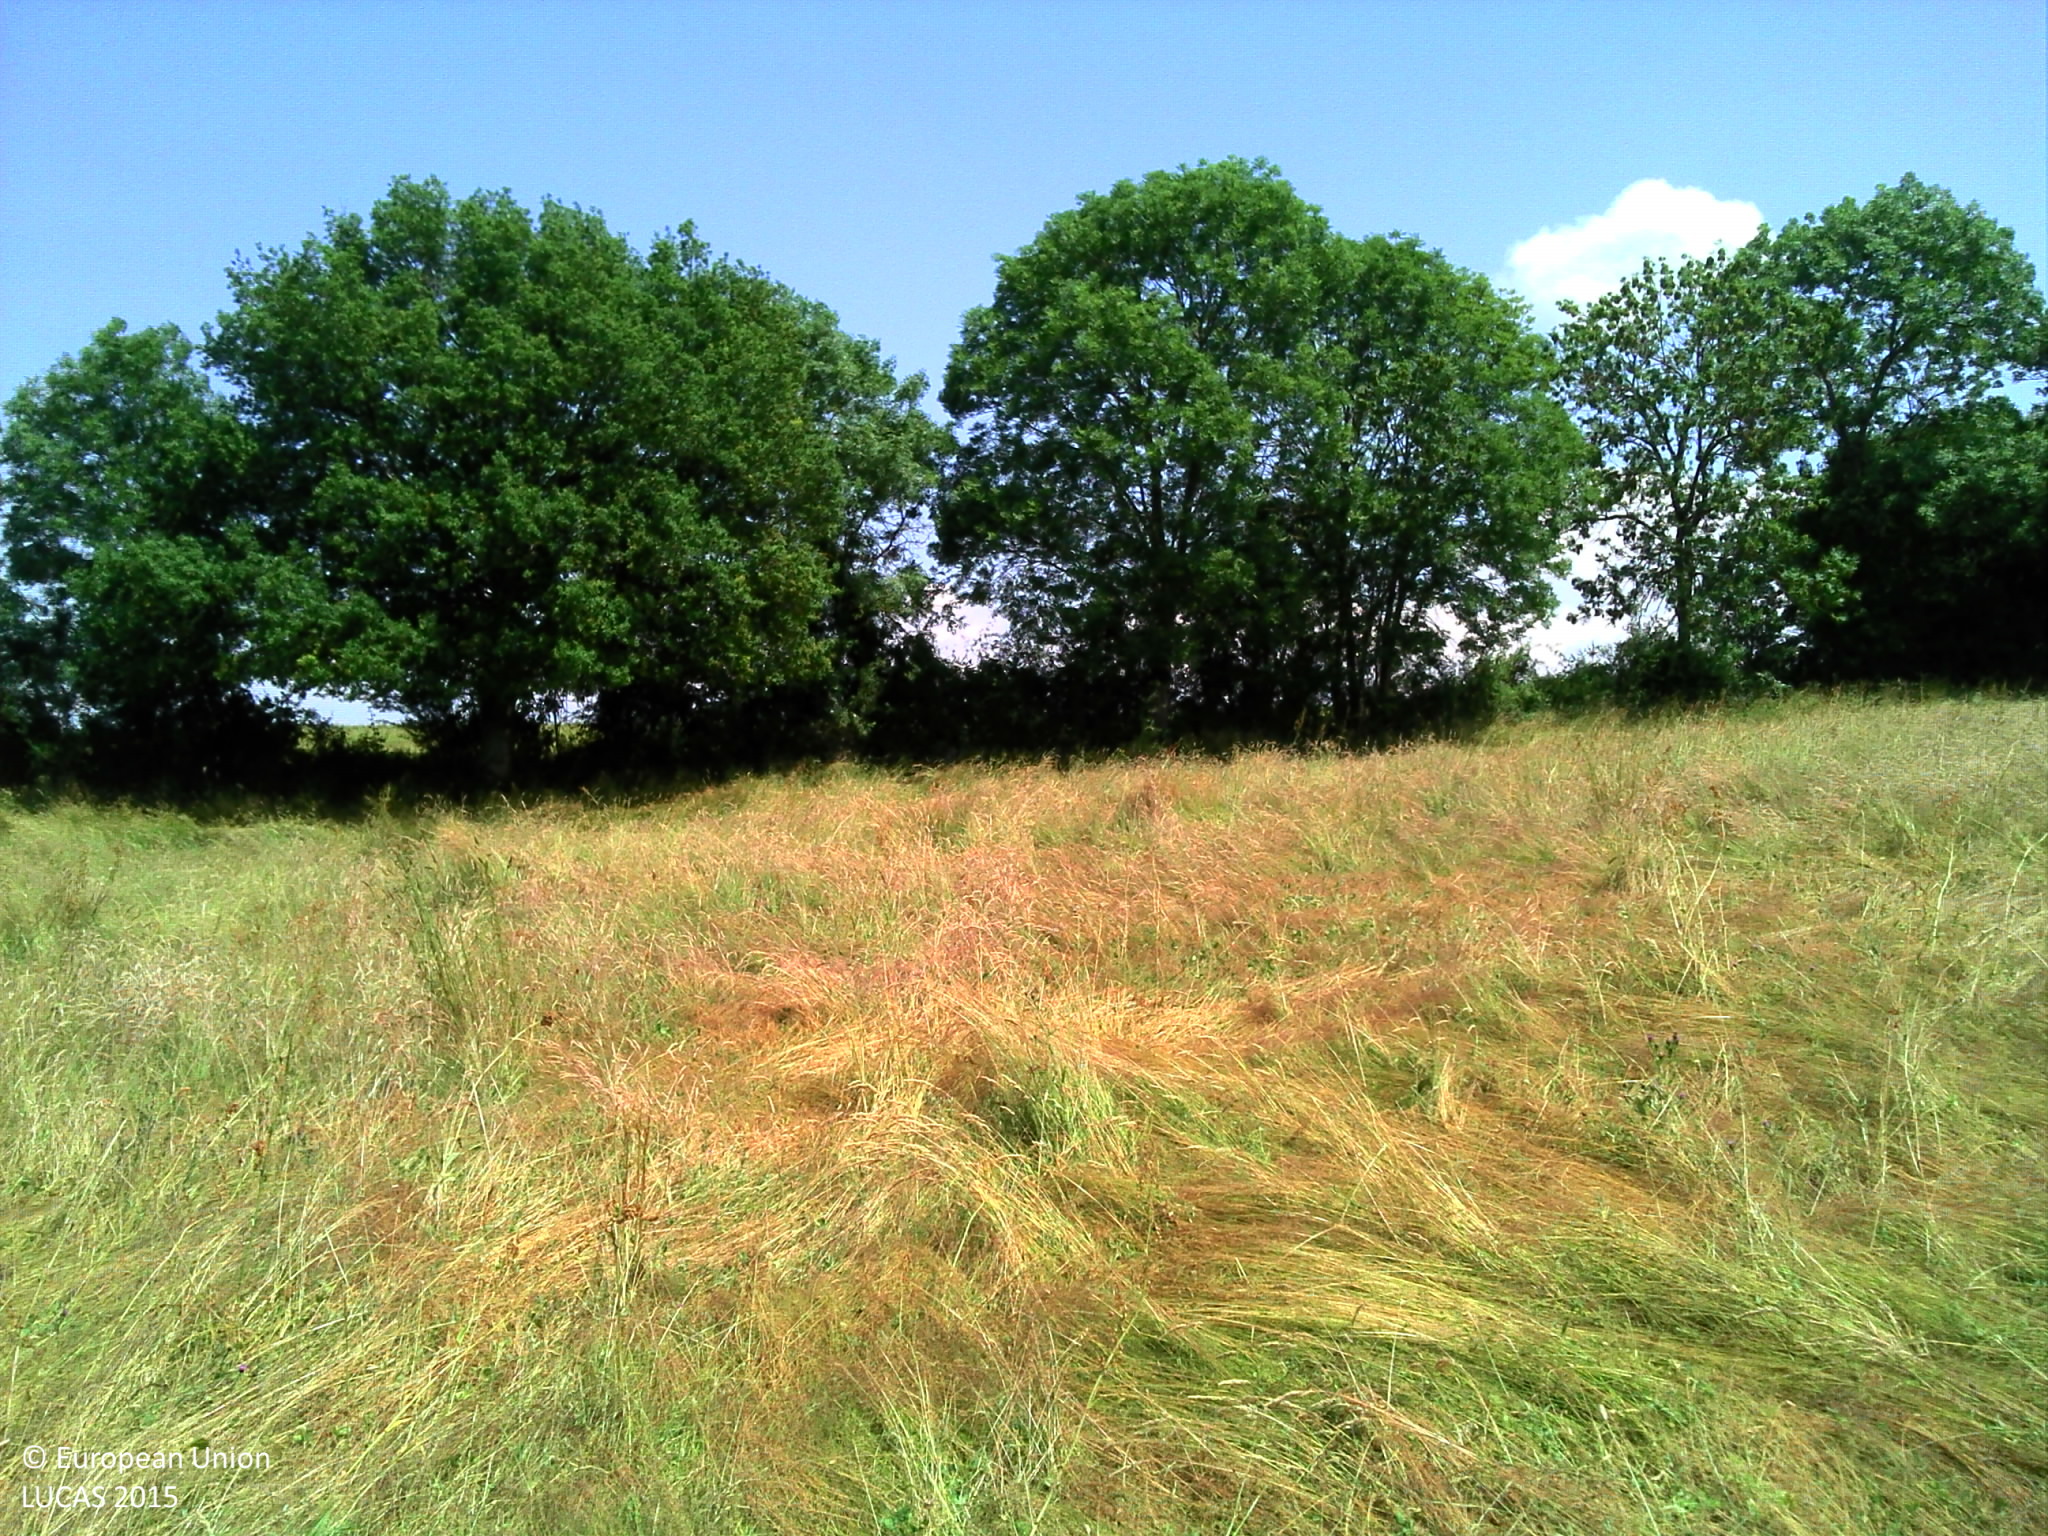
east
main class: Grassland
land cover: Grassland without tree/shrub cover
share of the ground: > 75 %
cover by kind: herbaceous plants 100 %
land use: Agriculture (excluding fallow land and kitchen gardens)
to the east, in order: Grassland without tree/shrub cover; Fences; Lines of trees; Managed hedges; Fences; Grassland without tree/shrub cover; Fences; Grassland with sparse tree/shrub cover
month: June
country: FR
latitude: 46.3400
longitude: 3.0209
